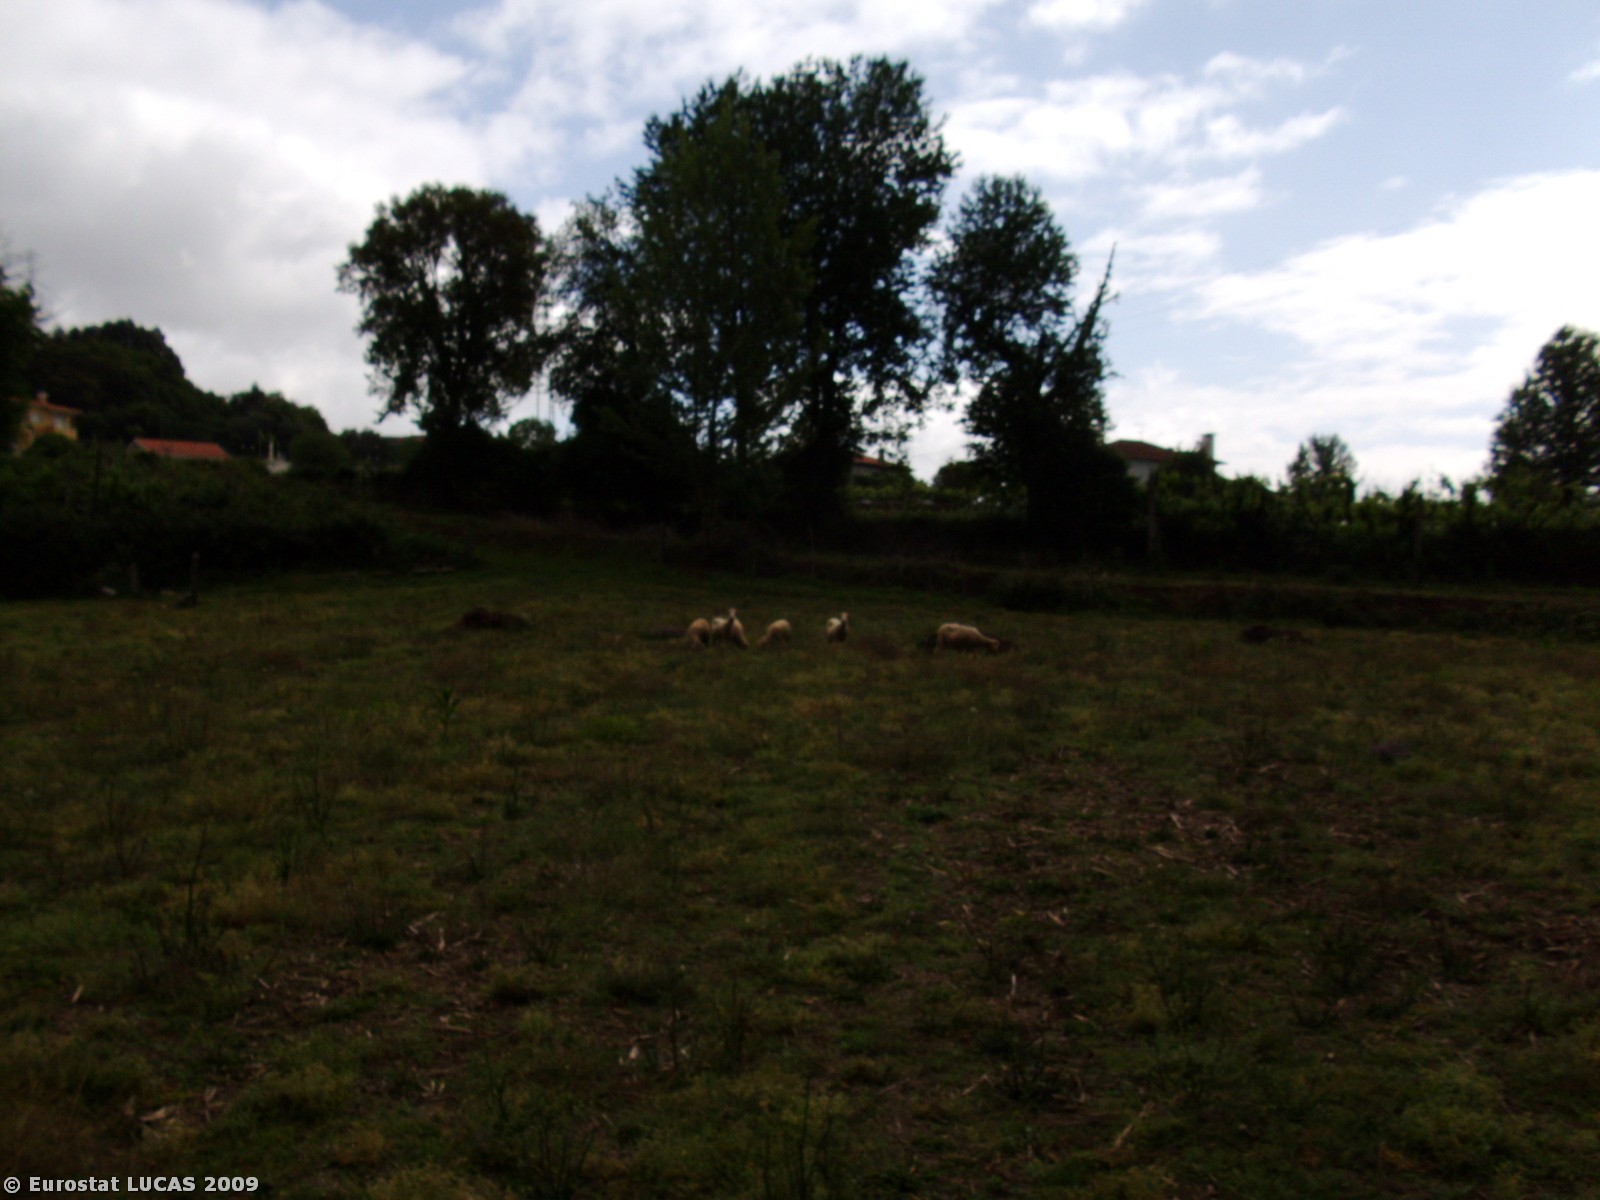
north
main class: Grassland
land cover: Spontaneously vegetated surfaces
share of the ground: > 75 %
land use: Fallow land
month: May
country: PT
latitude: 41.5928
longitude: -8.5243
